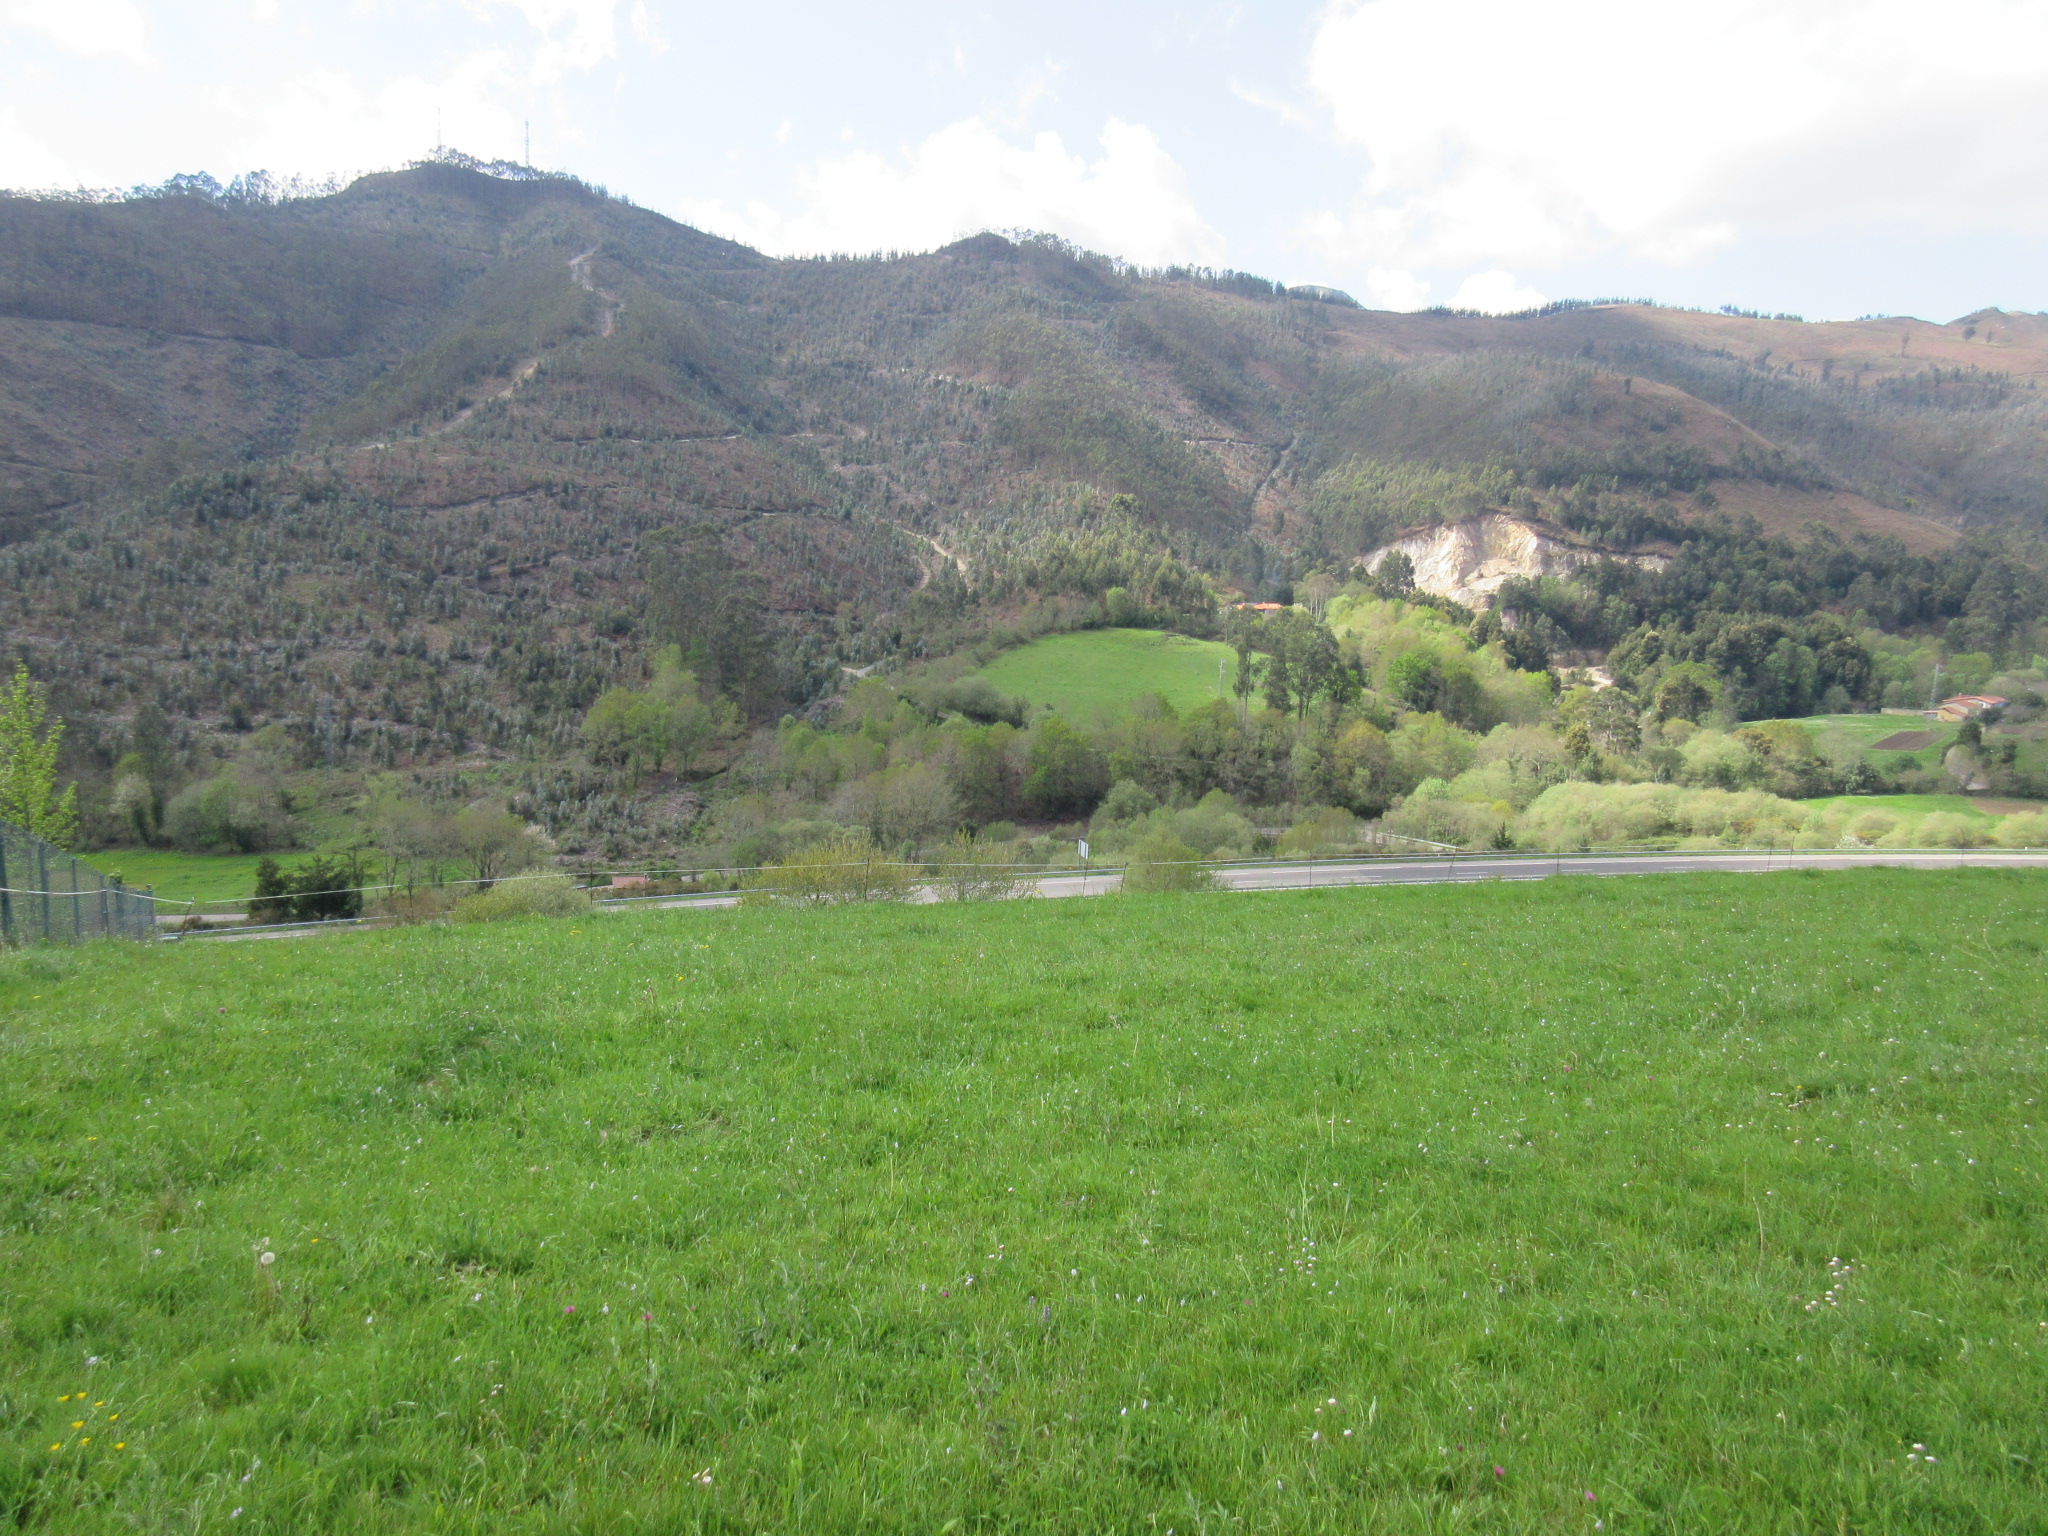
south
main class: Grassland
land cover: Grassland without tree/shrub cover
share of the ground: > 75 %
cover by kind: herbaceous plants 100 %
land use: Agriculture (excluding fallow land and kitchen gardens)
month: April
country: ES
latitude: 43.4419
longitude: -5.0844
